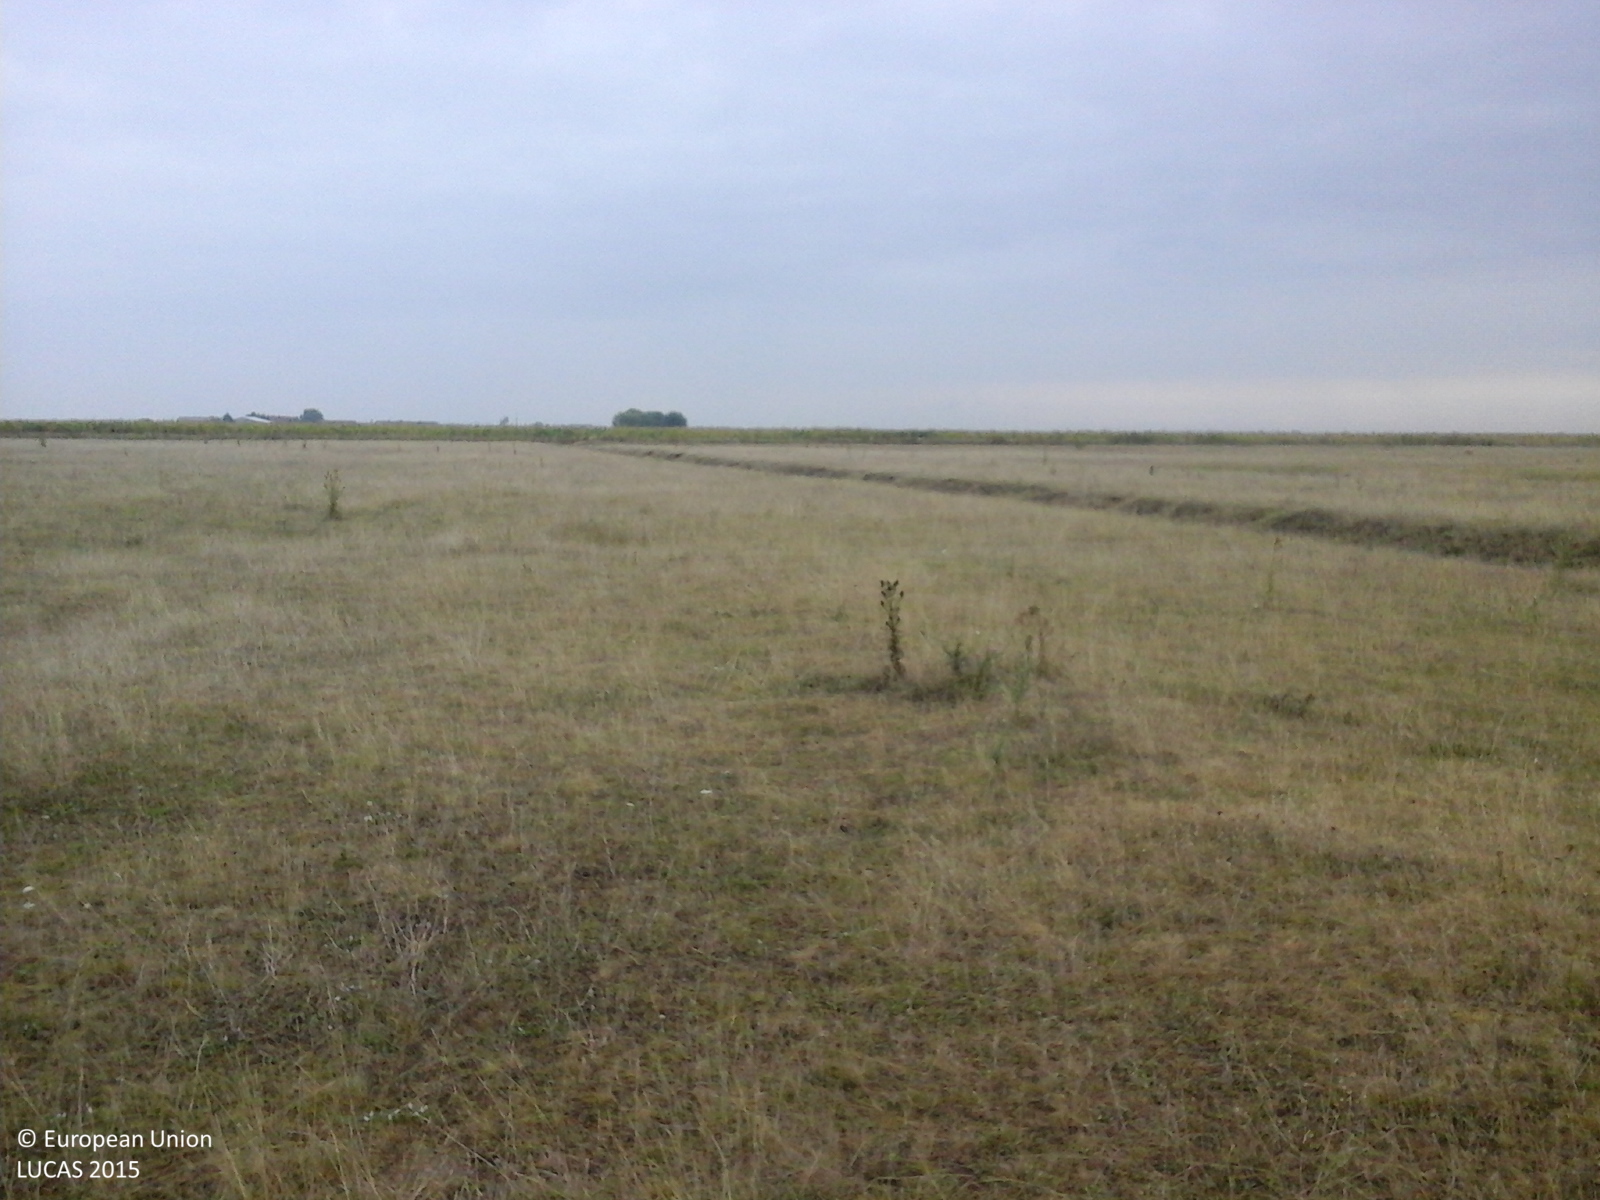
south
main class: Grassland
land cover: Grassland without tree/shrub cover
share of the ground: > 75 %
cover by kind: herbaceous plants 100 %
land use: Agriculture (excluding fallow land and kitchen gardens)
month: August
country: RO
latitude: 45.6852
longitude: 21.0577
